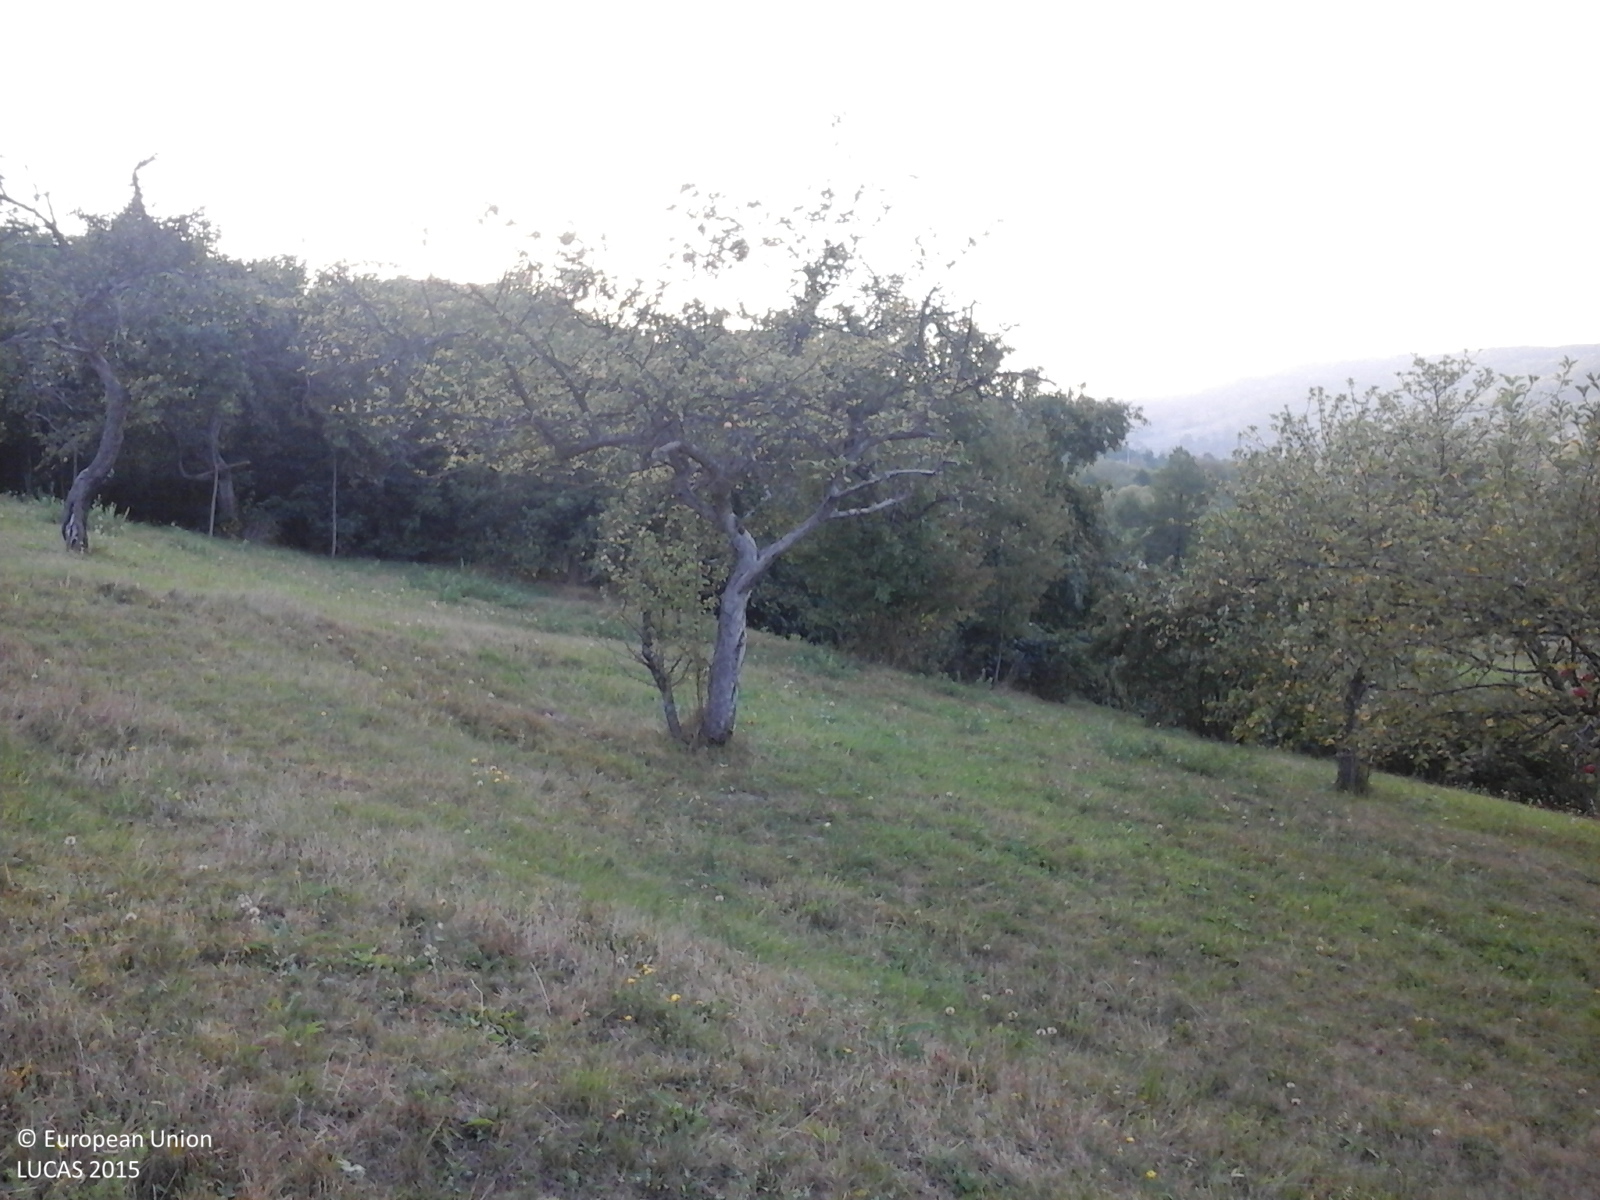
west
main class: Cropland
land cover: Apple fruit
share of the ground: 25 - 50 %
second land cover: Grassland without tree/shrub cover
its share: > 75 %
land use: Agriculture (excluding fallow land and kitchen gardens)
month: September
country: RO
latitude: 47.8305
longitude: 24.1826
